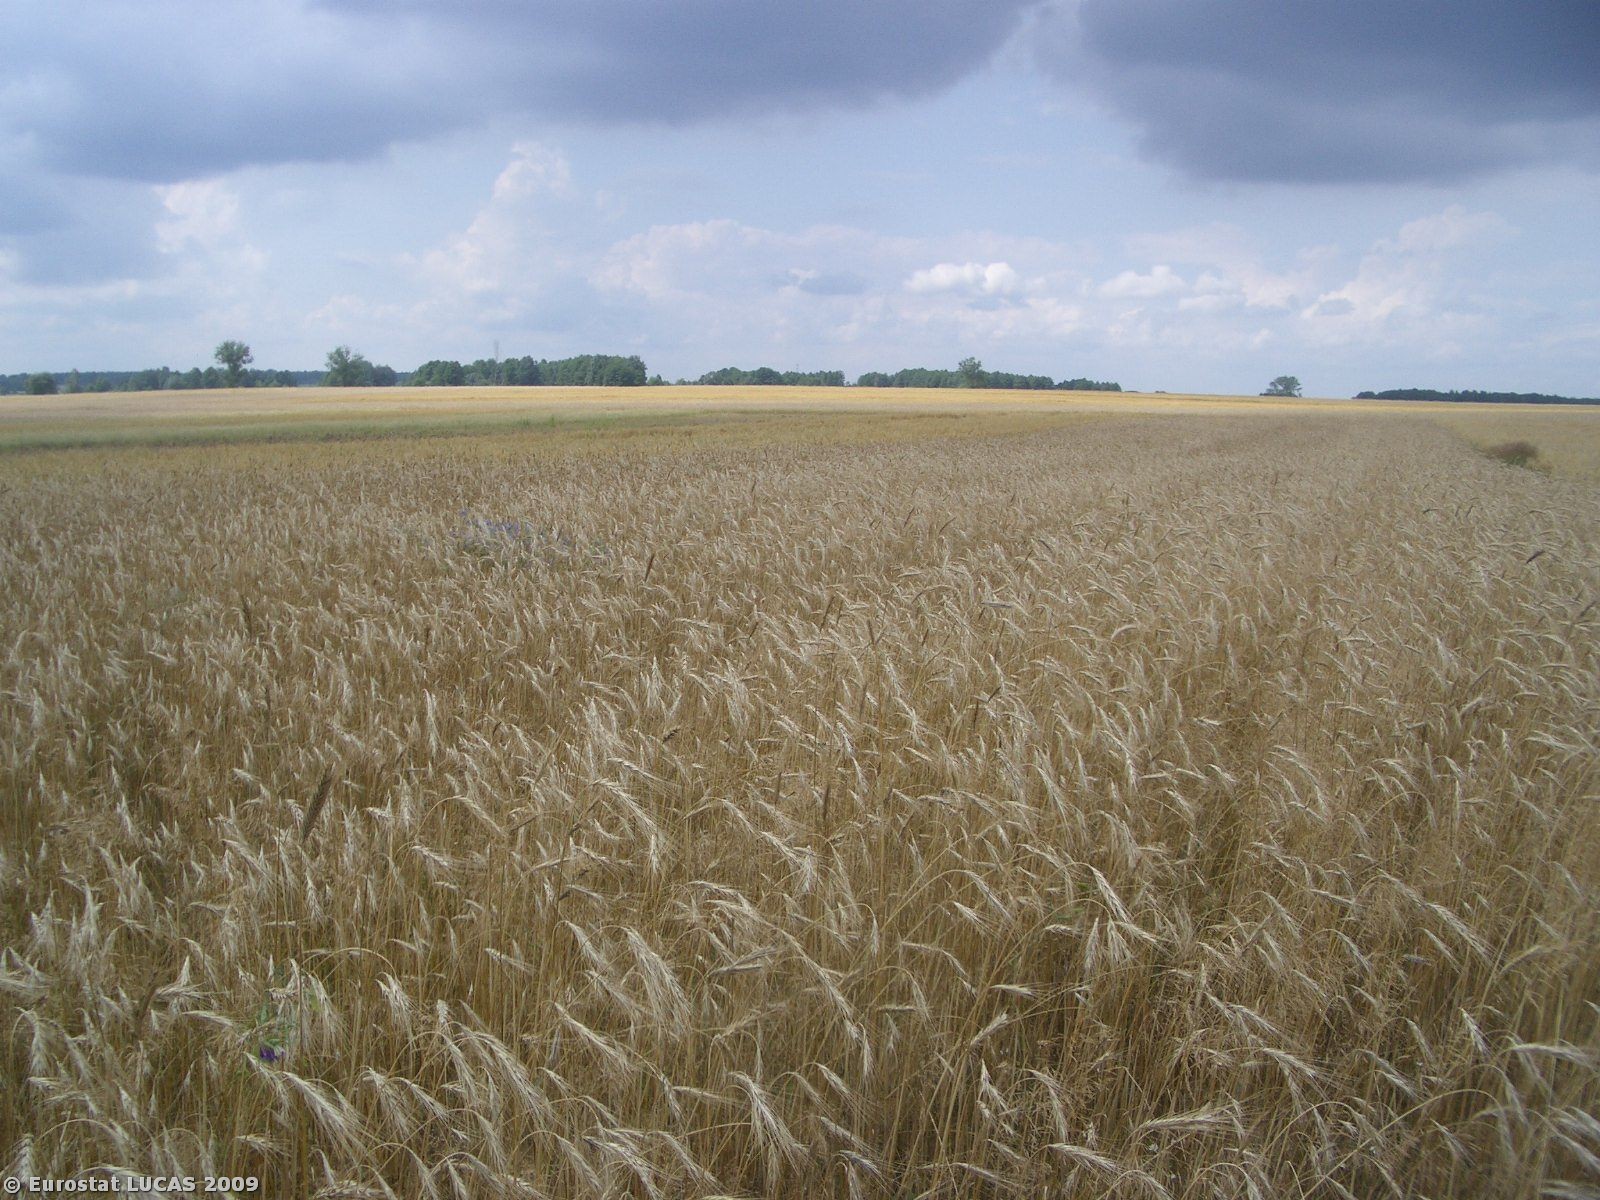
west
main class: Cropland
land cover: Rye
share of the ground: > 75 %
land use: Agriculture (excluding fallow land and kitchen gardens)
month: July
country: PL
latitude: 51.7489
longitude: 22.5090
